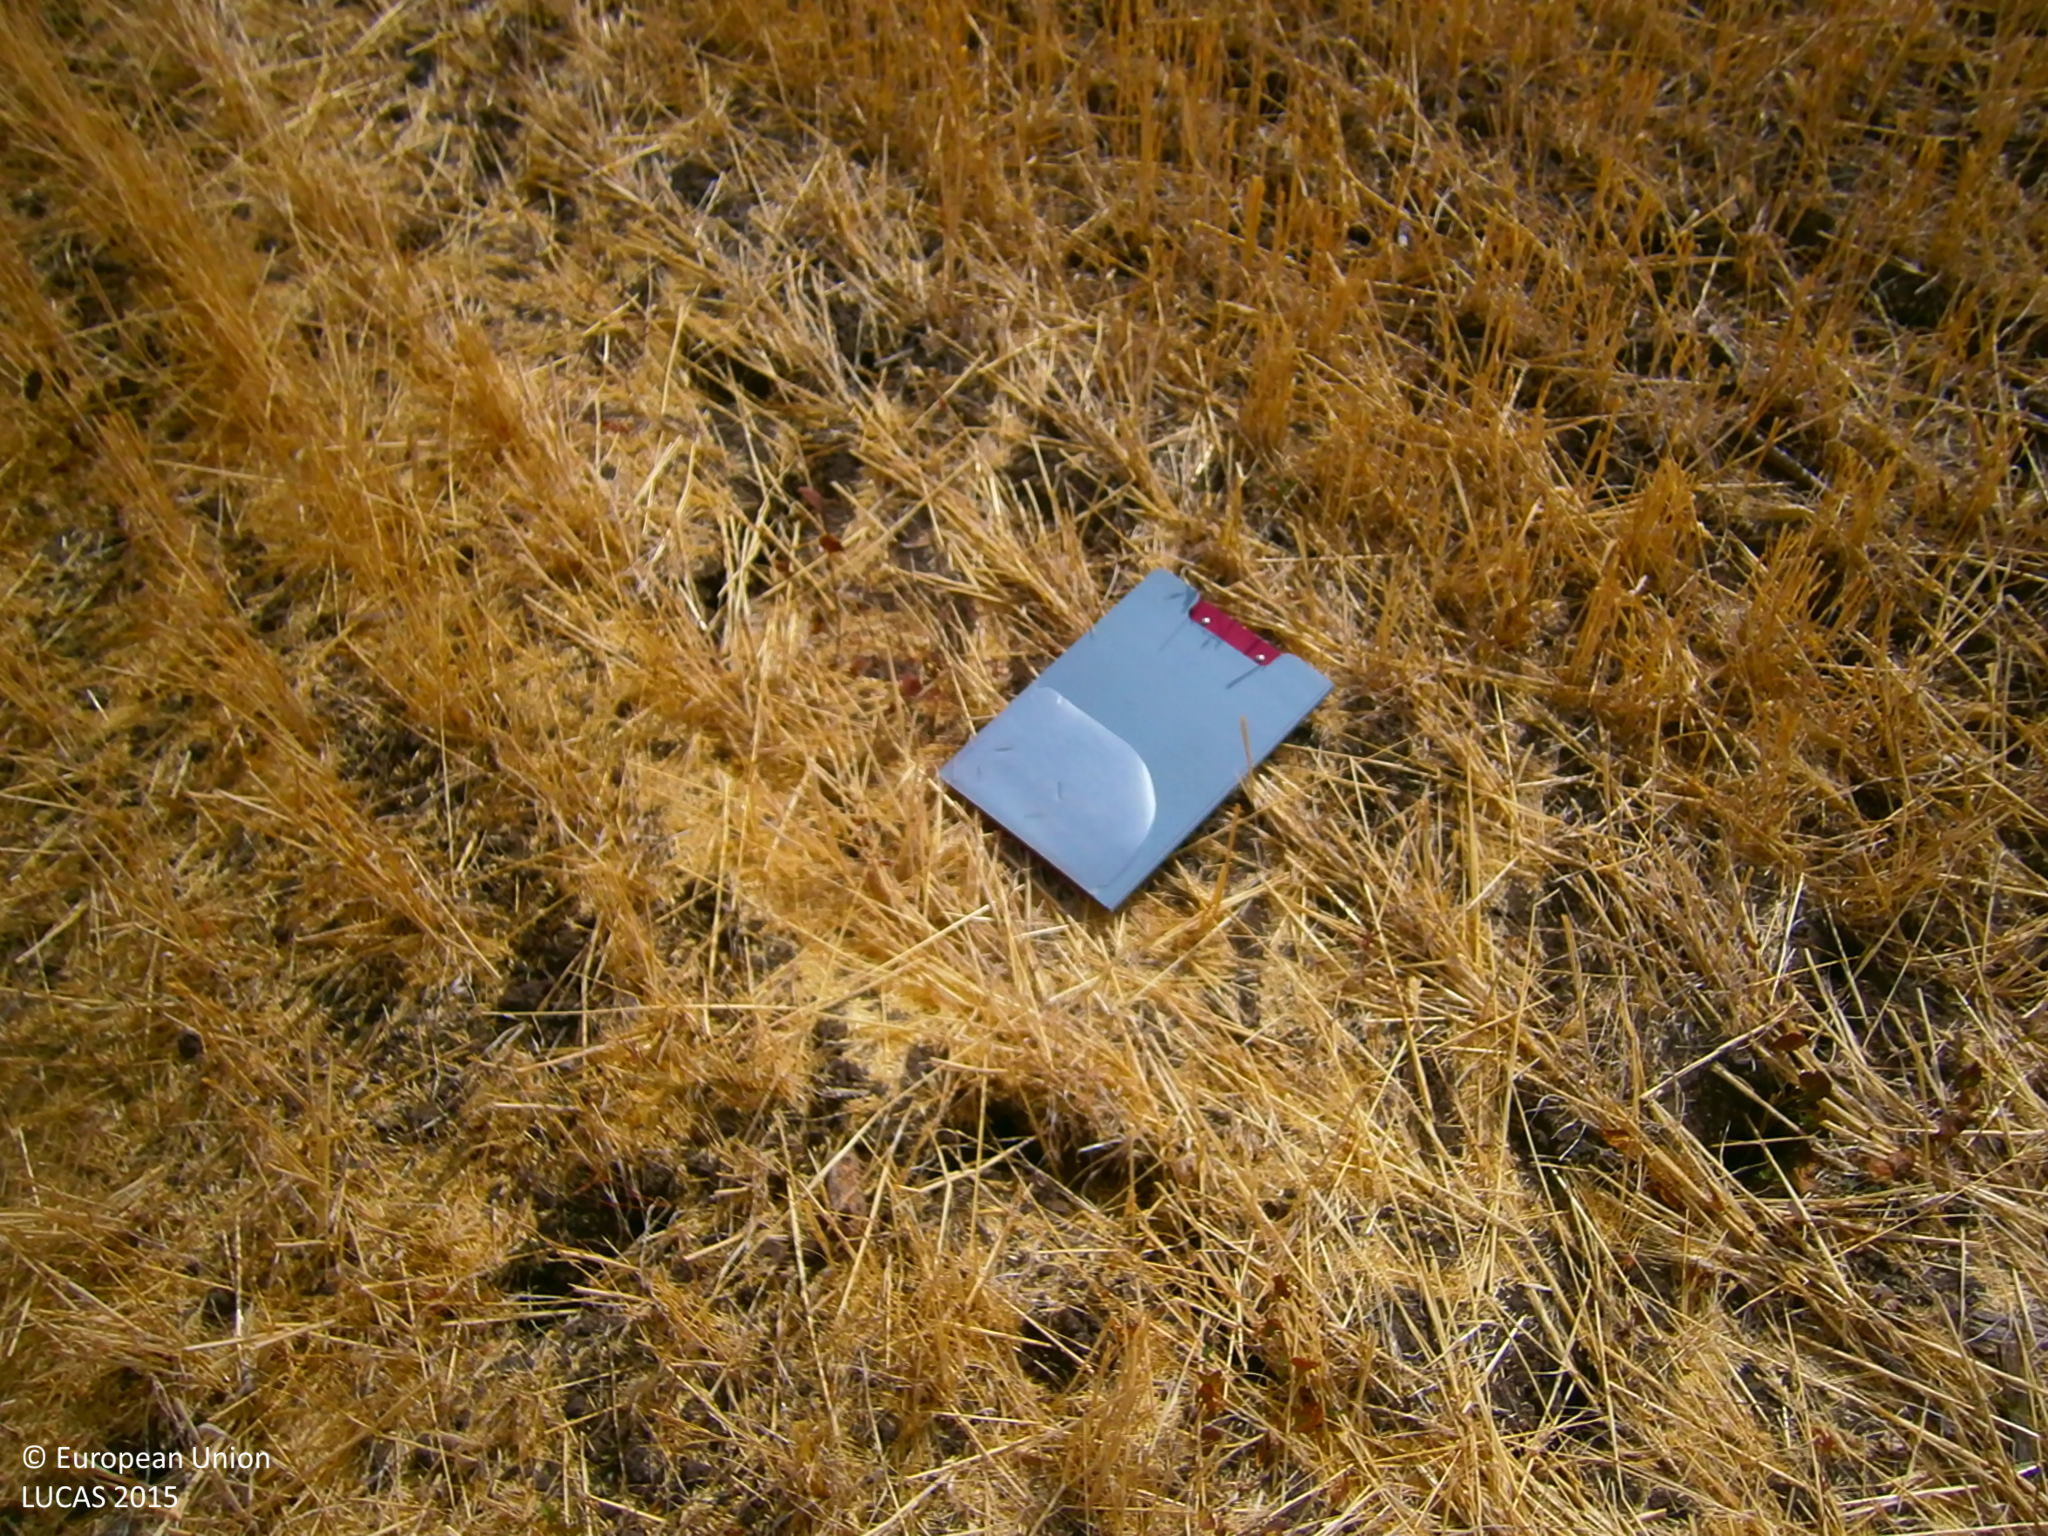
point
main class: Cropland
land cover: Durum wheat
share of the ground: > 75 %
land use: Agriculture (excluding fallow land and kitchen gardens)
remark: Harvested field
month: July
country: ES
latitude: 38.7226
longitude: -6.9631
